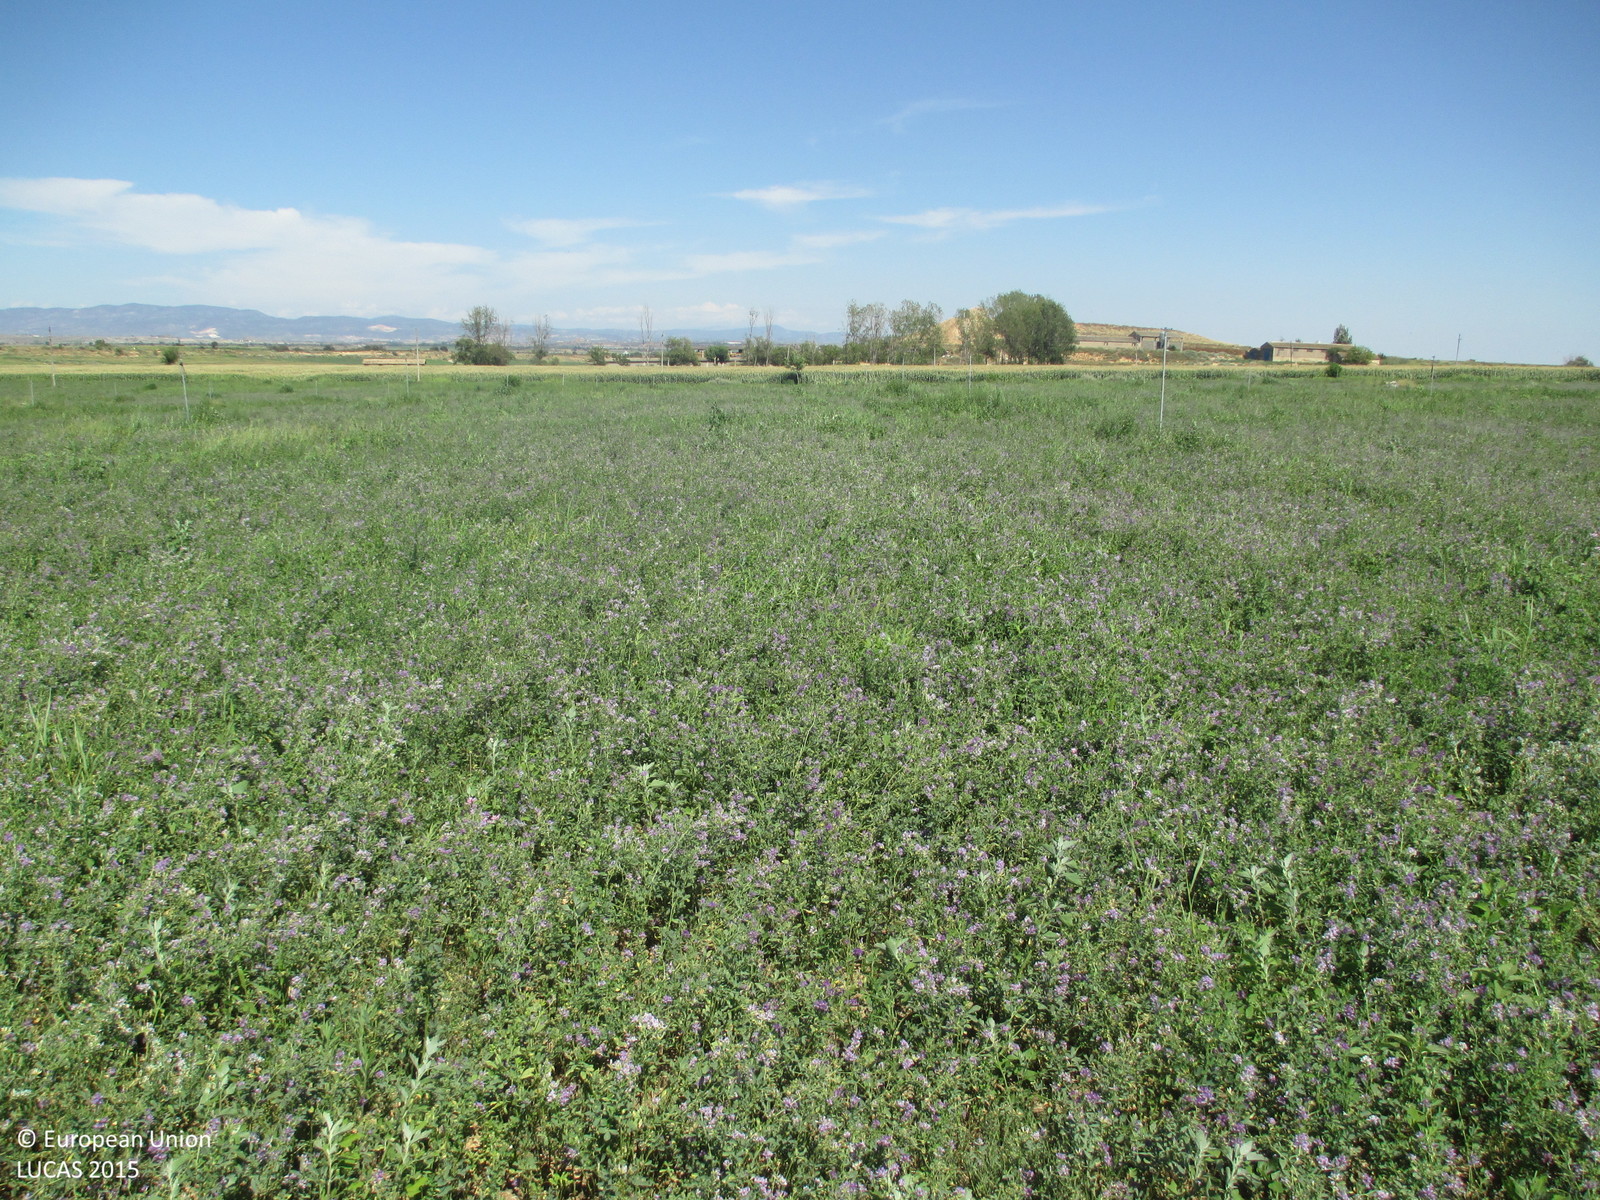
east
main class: Cropland
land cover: Lucerne
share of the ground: > 75 %
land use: Agriculture (excluding fallow land and kitchen gardens)
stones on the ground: < 10 %
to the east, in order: Lucerne; Shruby margins; Maize; Electric lines; Maize
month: July
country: ES
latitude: 41.9273
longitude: 0.0576
